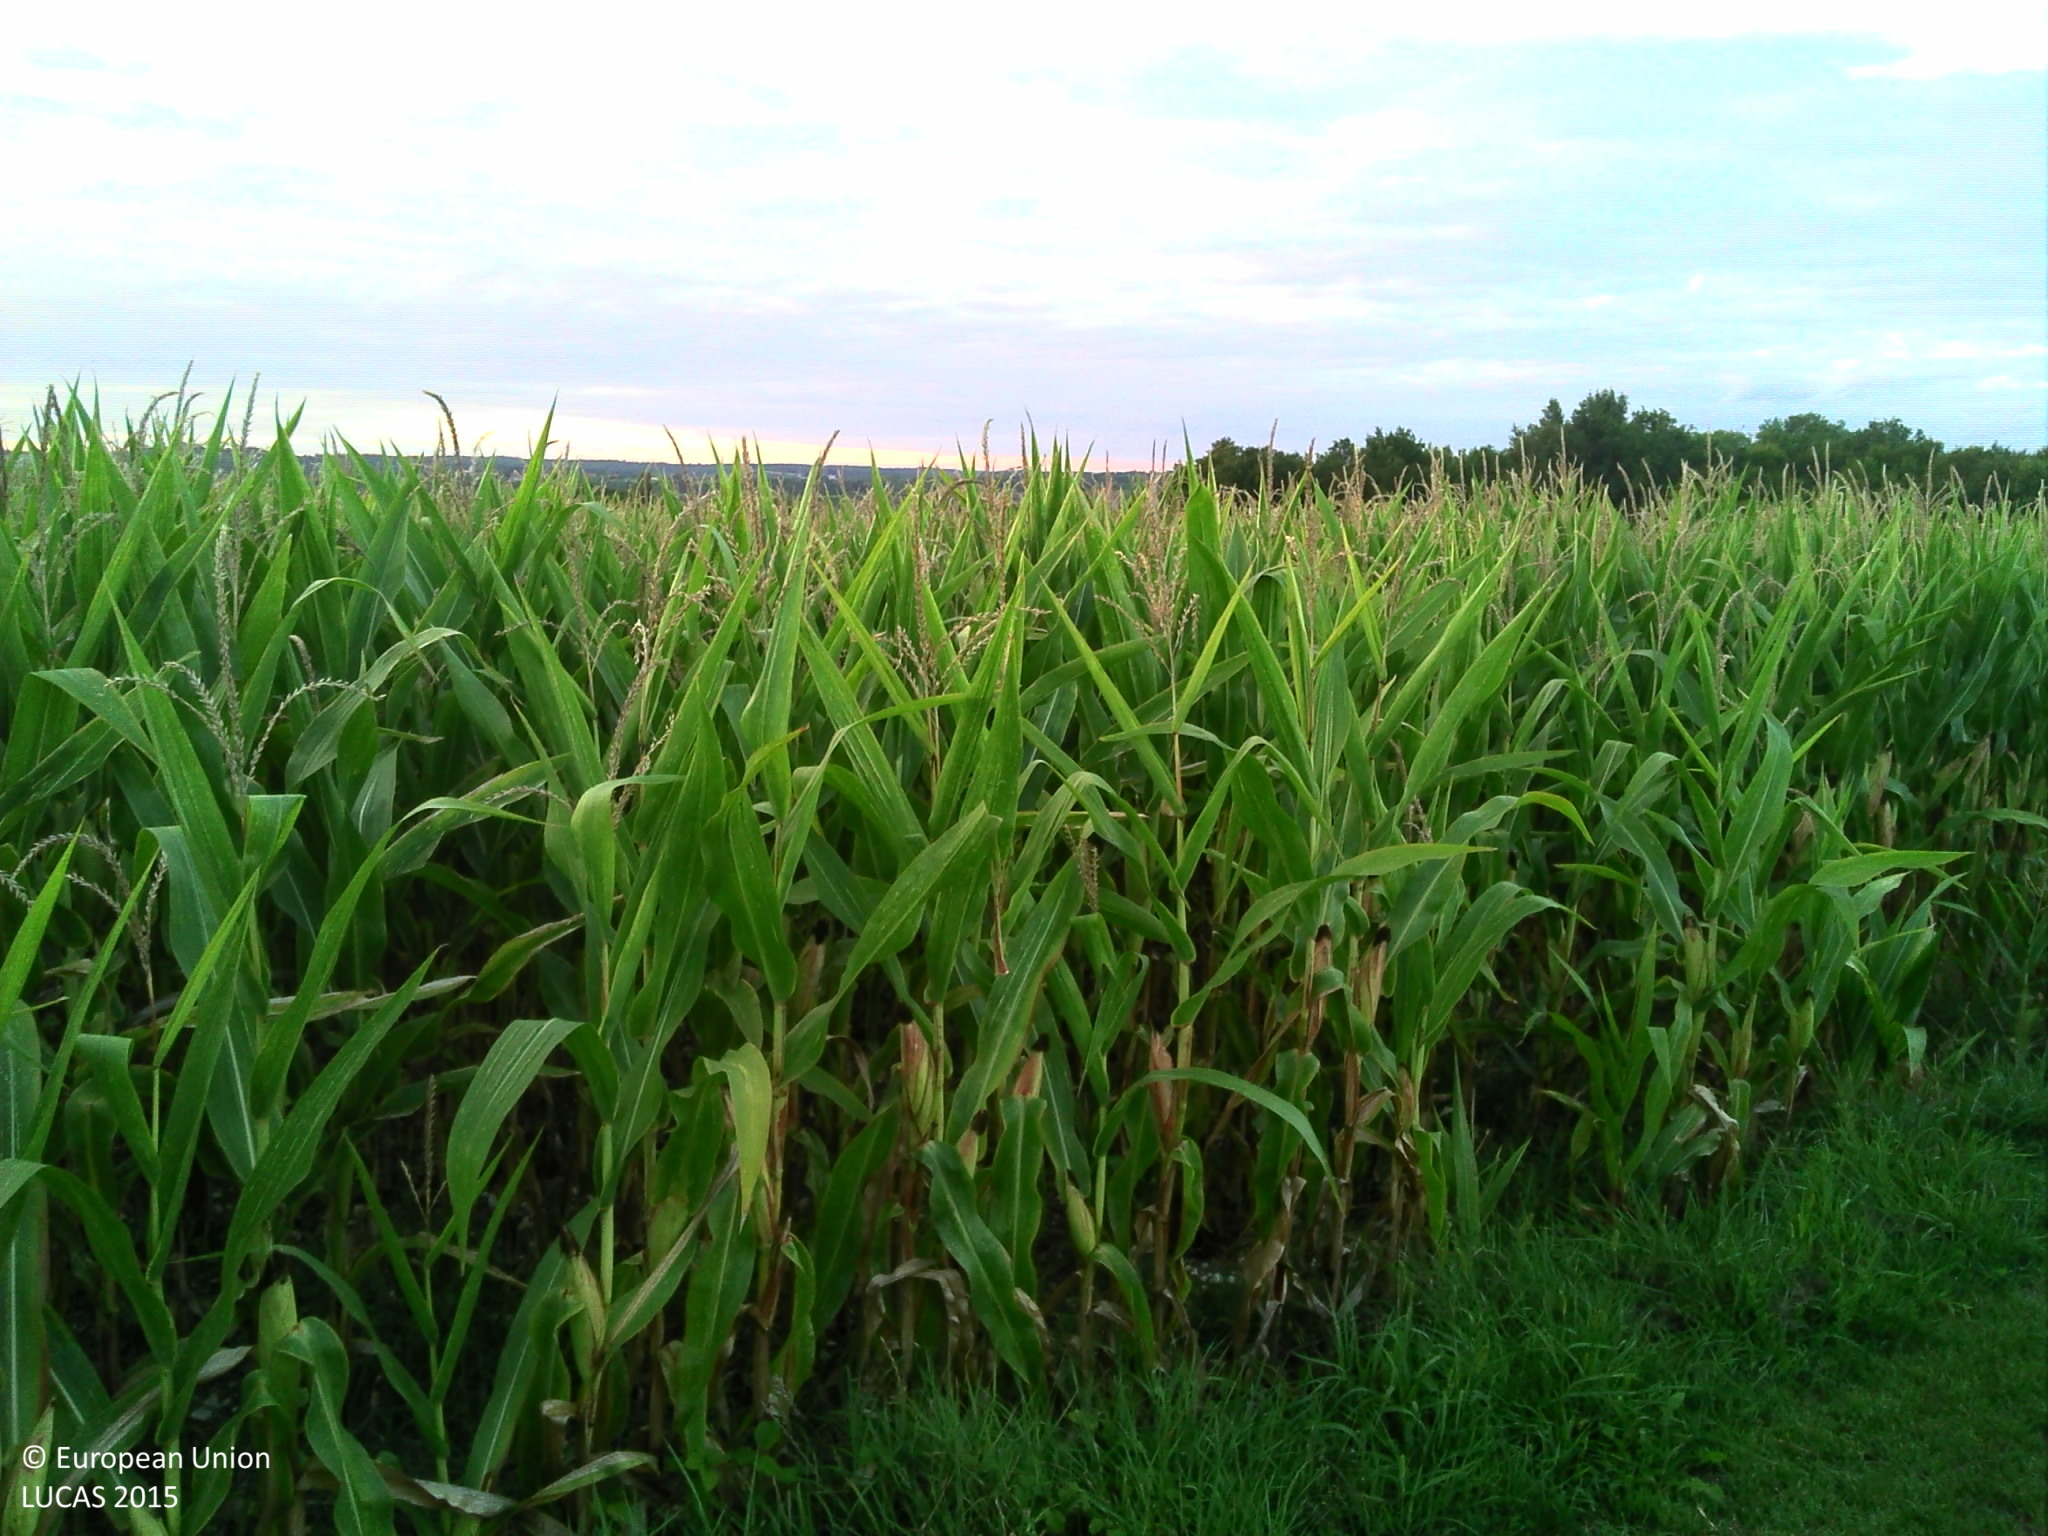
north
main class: Cropland
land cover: Sunflower
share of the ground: > 75 %
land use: Agriculture (excluding fallow land and kitchen gardens)
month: August
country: FR
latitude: 45.2336
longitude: 0.4474
